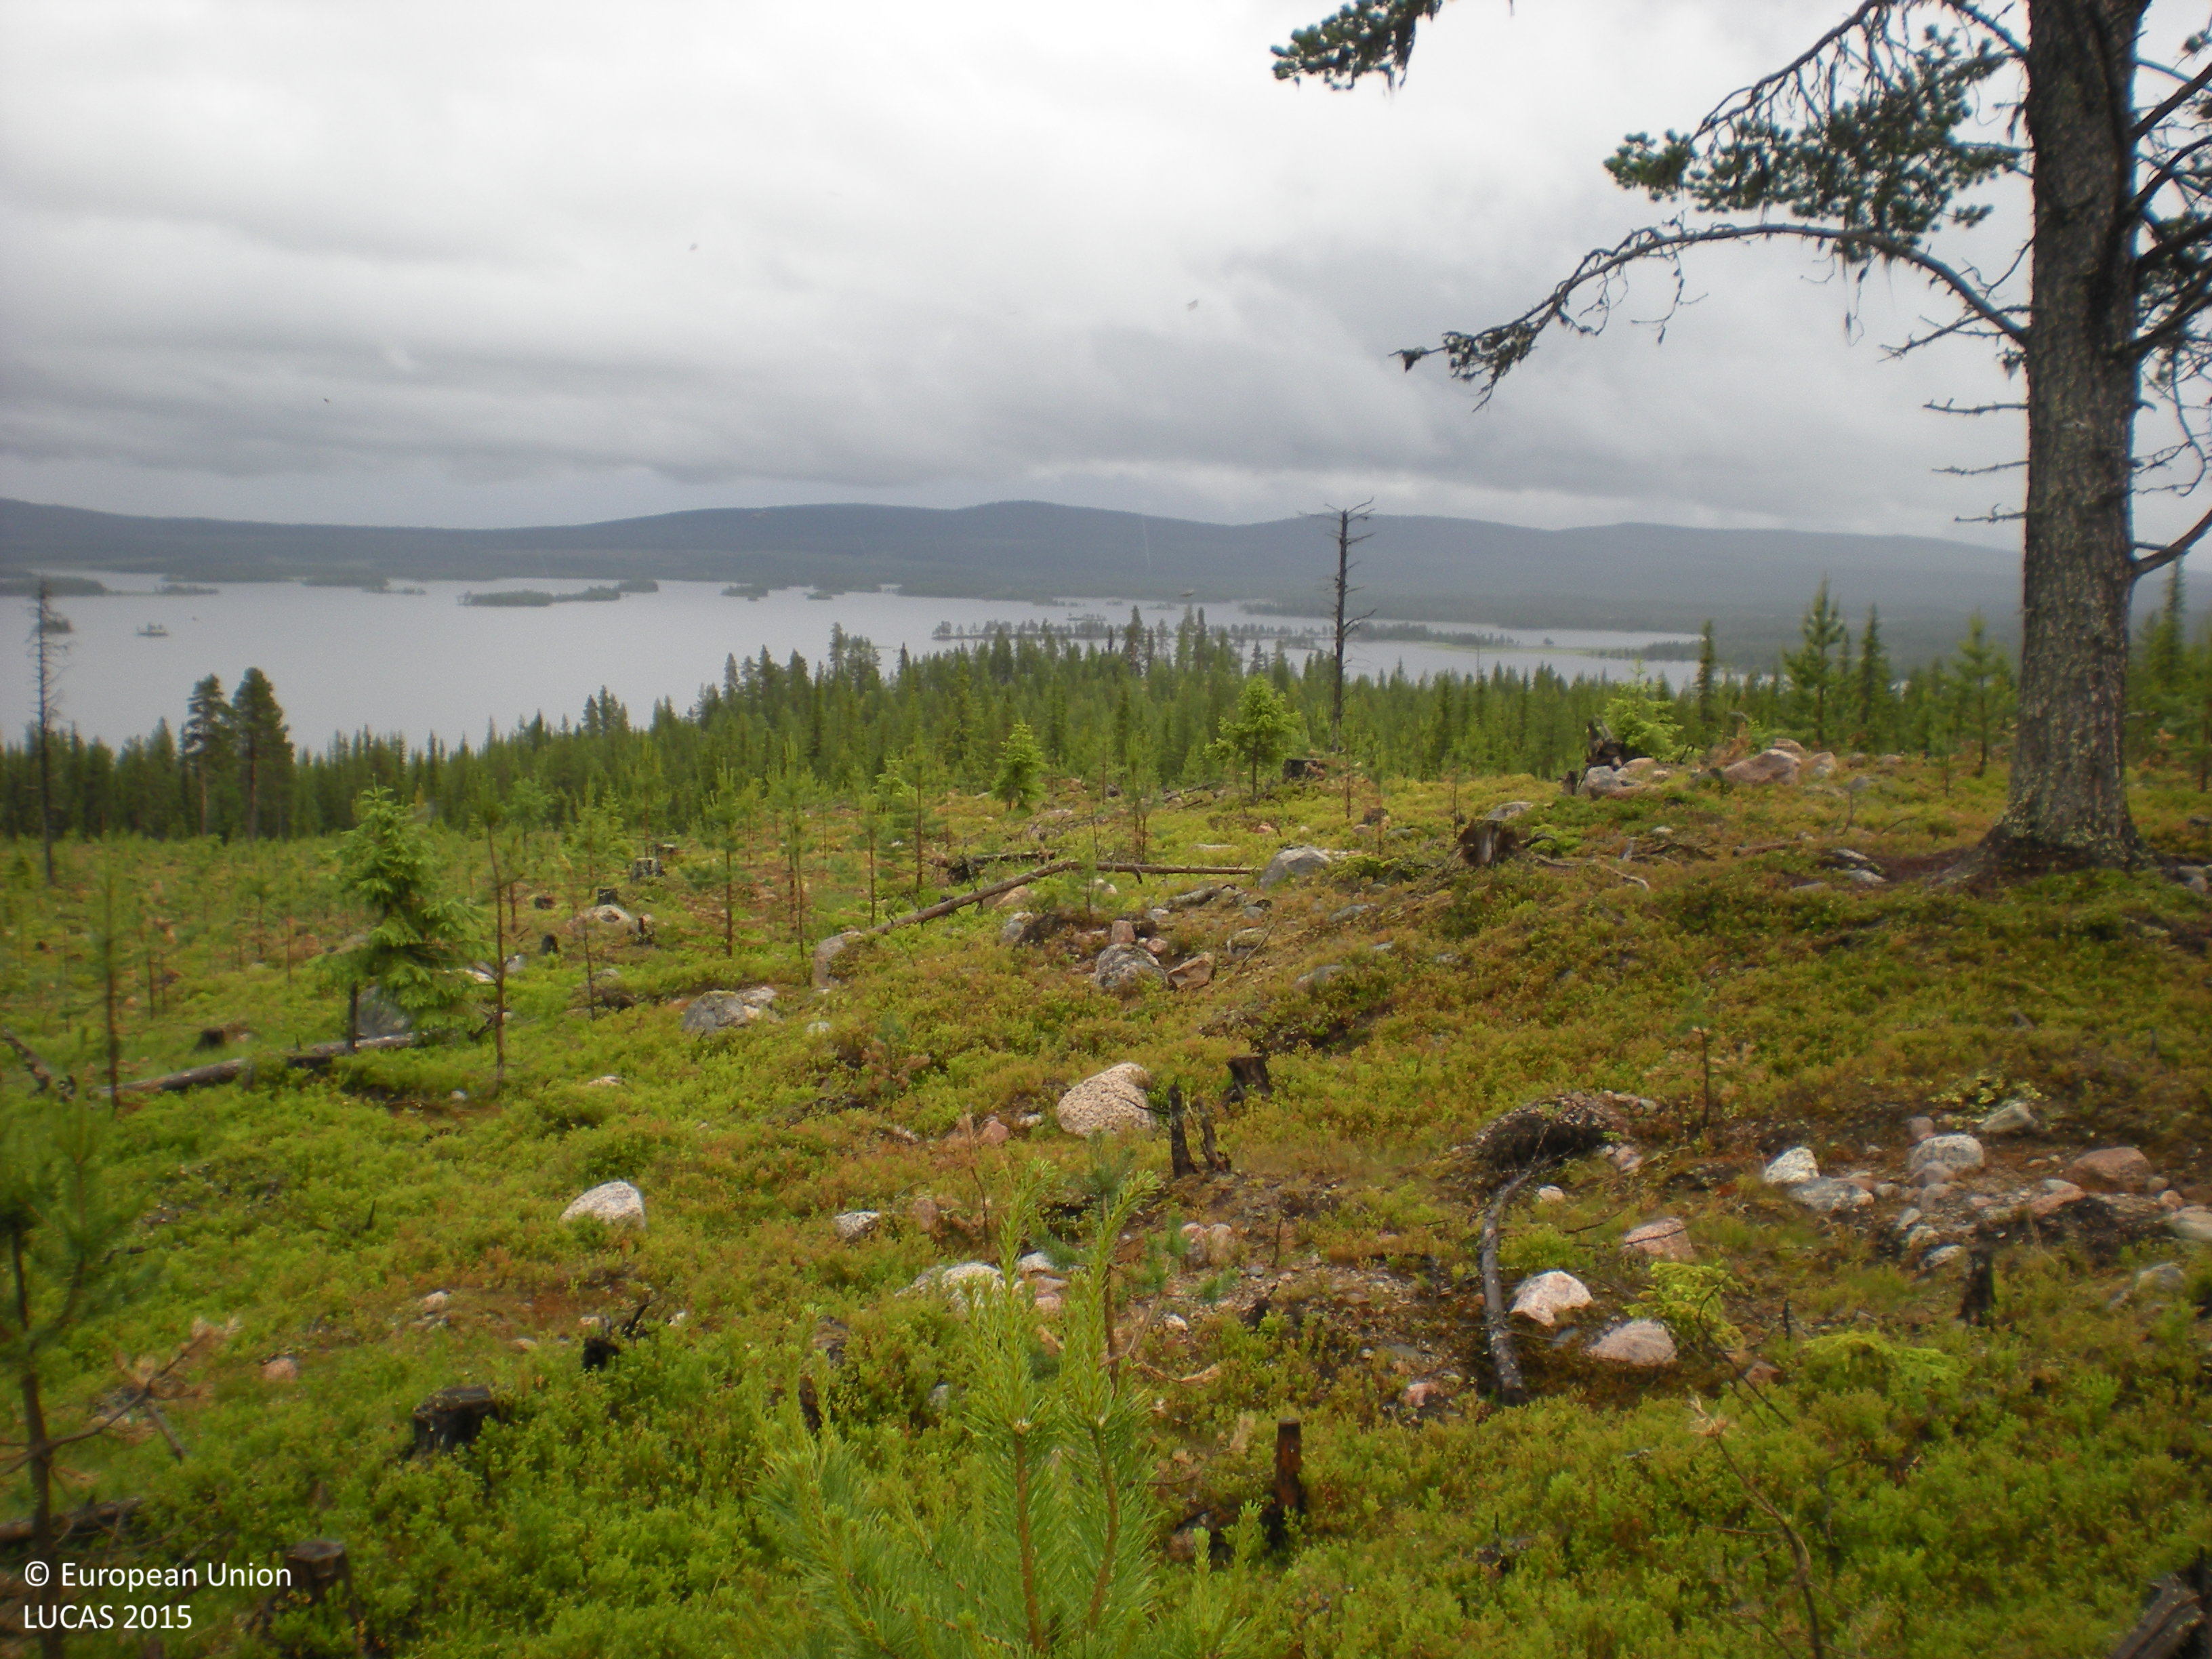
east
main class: Woodland
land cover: Pine dominated coniferous woodland
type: boreal forest
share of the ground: 25 - 50 %
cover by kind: shrubs 55 %, coniferous forest trees 30 %, lichens and mosses 10 %, herbaceous plants 5 %
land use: Forestry
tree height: < 5 m
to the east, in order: Pine dominated coniferous woodland; Spruce dominated coniferous woodland
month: July
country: SE
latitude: 65.8449
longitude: 17.7316
